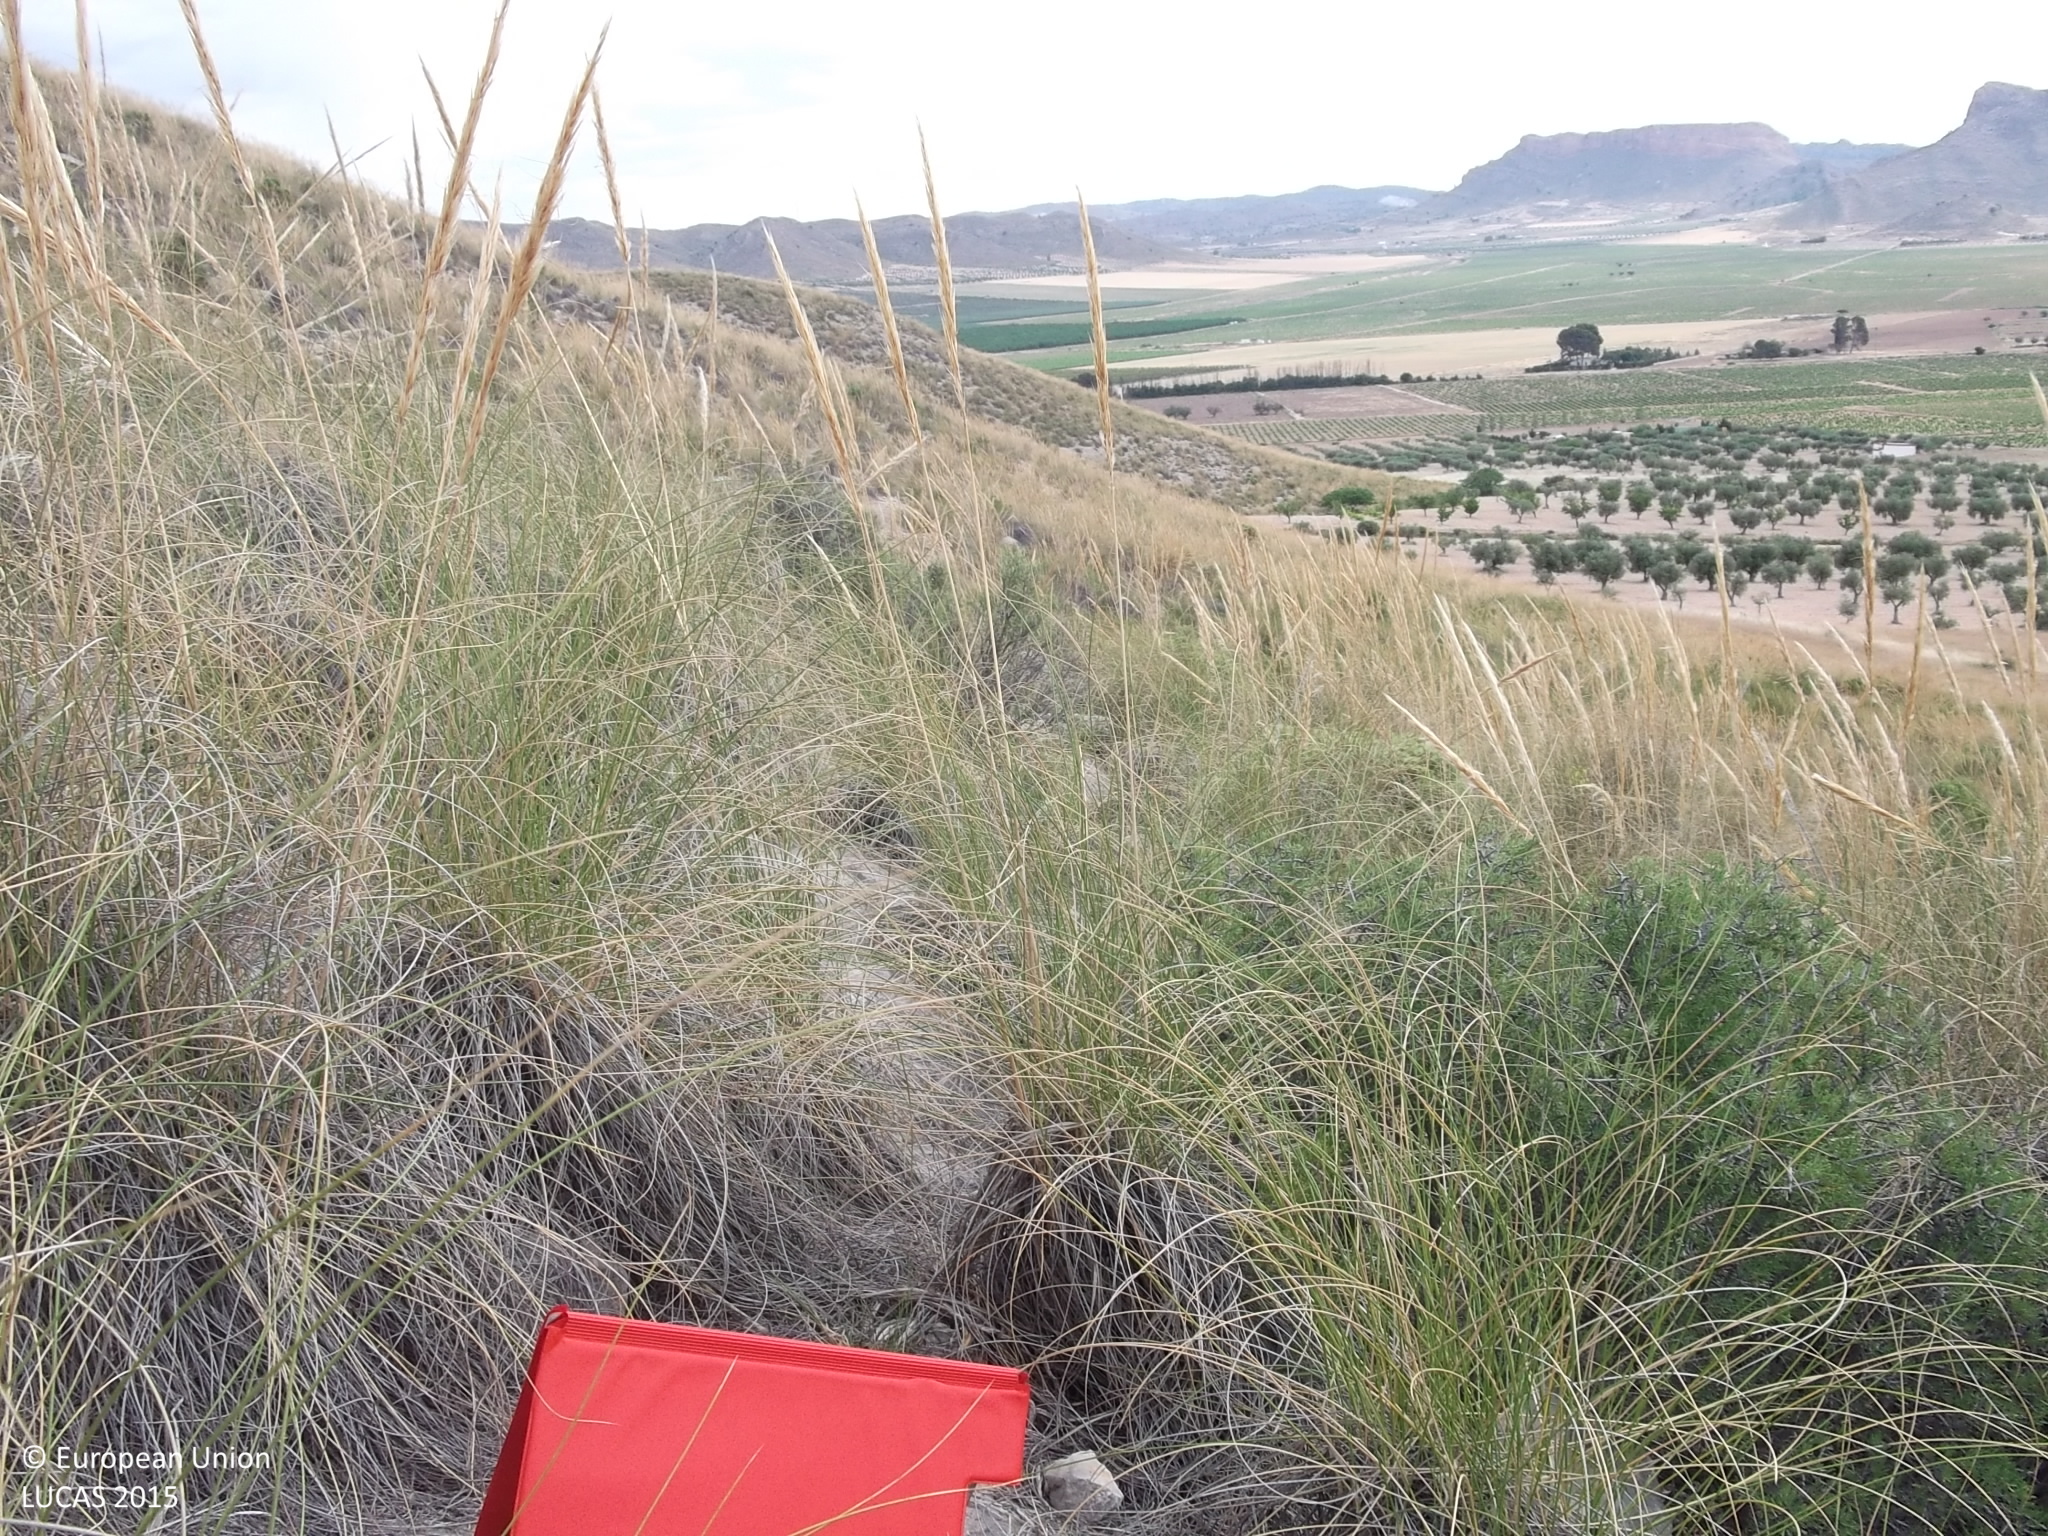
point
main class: Shrubland
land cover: Shrubland without tree cover
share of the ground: 25 - 50 %
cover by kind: consolidated bare surface 40 %, shrubs 30 %, herbaceous plants 30 %
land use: Semi-natural and natural areas not in use
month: May
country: ES
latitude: 38.5071
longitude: -1.3786
